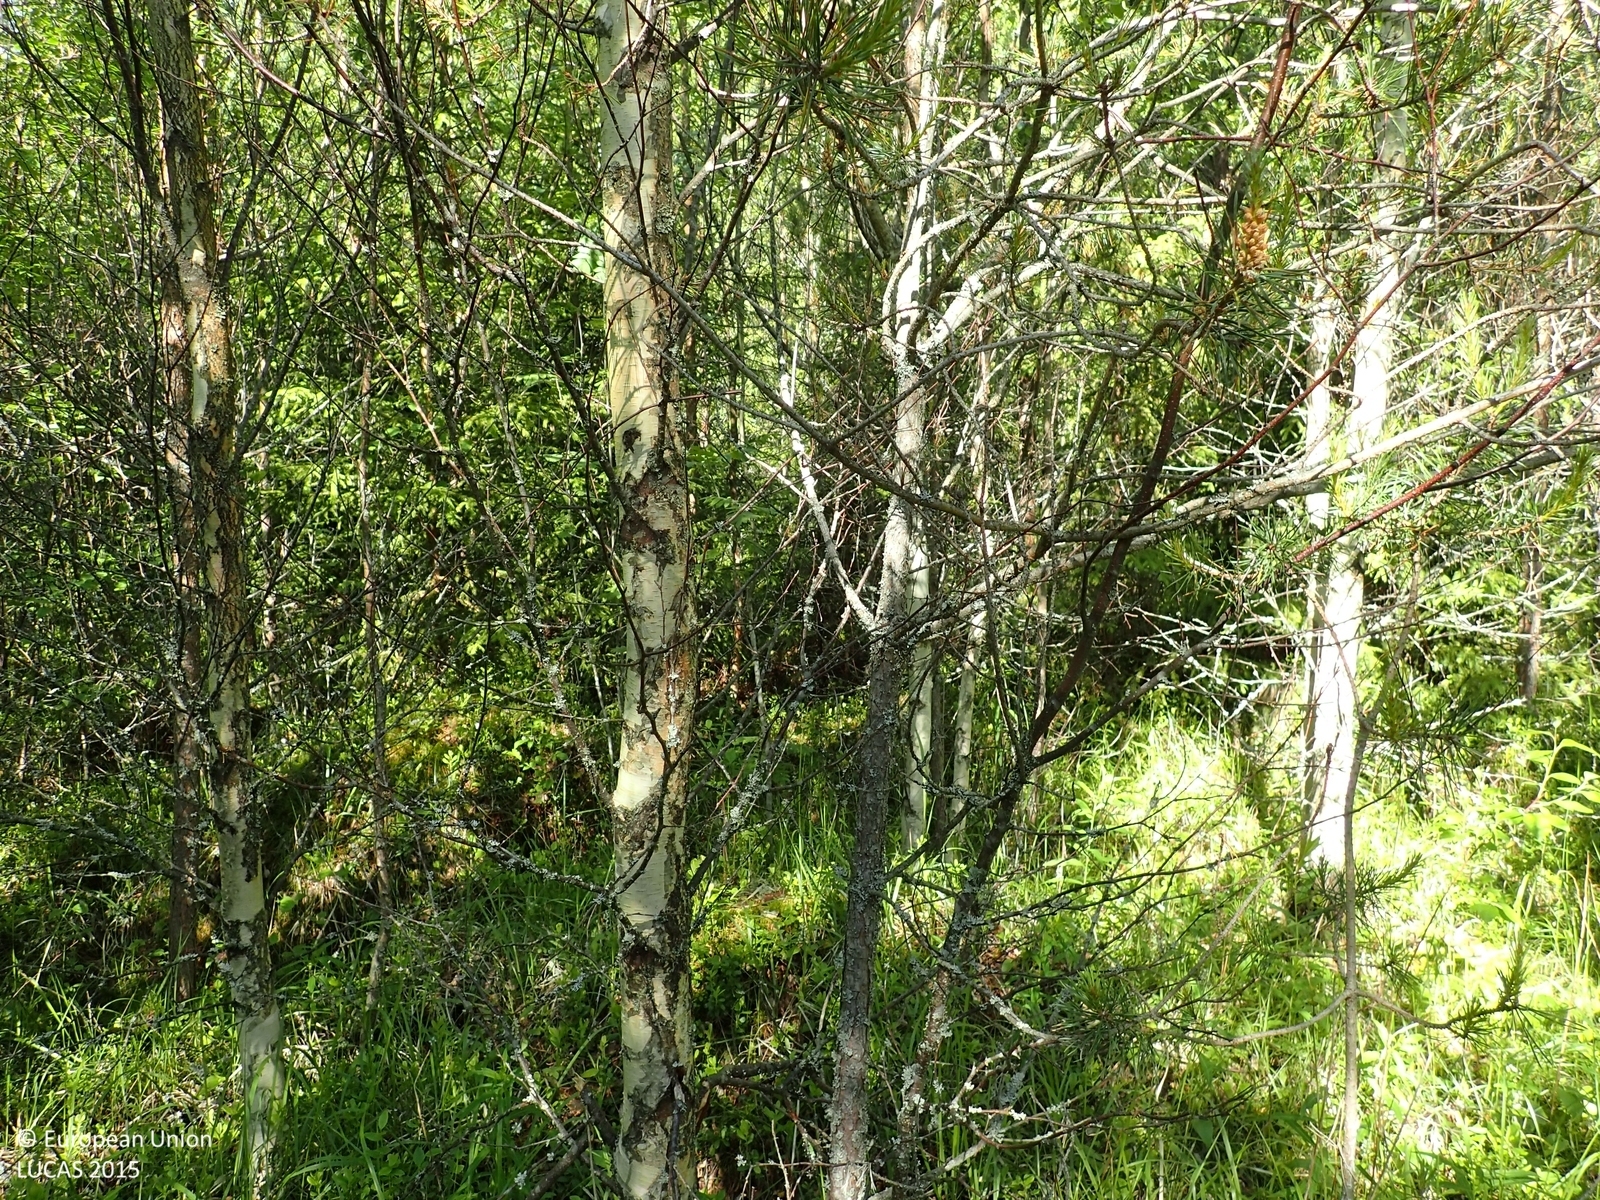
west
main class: Woodland
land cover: Pine dominated mixed woodland
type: boreal forest
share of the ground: > 75 %
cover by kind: coniferous forest trees 60 %, broadleaved forest trees 25 %, herbaceous plants 15 %
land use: Forestry
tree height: > 5 m
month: June
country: FI
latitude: 62.4000
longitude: 21.3611
